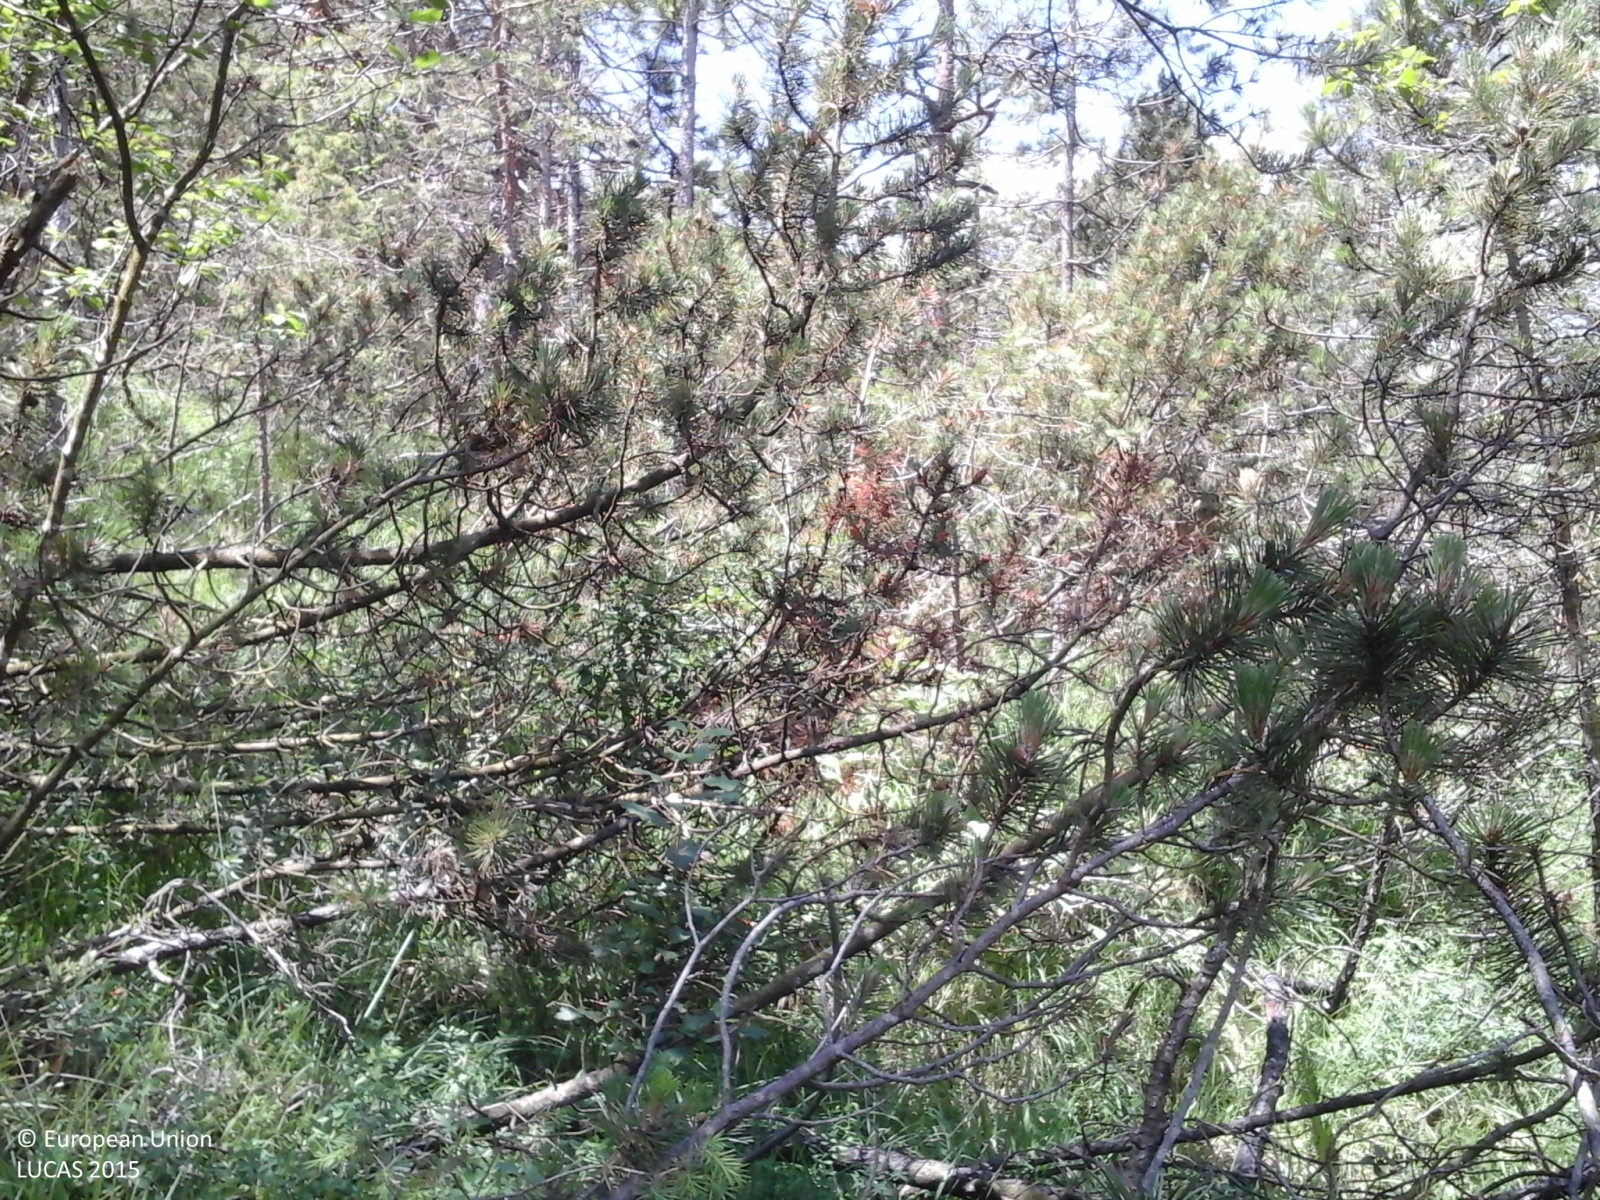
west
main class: Woodland
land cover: Pine dominated mixed woodland
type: alpine coniferous forest
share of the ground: > 75 %
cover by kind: coniferous forest trees 75 %, broadleaved forest trees 25 %
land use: Forestry
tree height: > 5 m
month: June
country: IT
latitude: 46.0339
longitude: 11.5354
